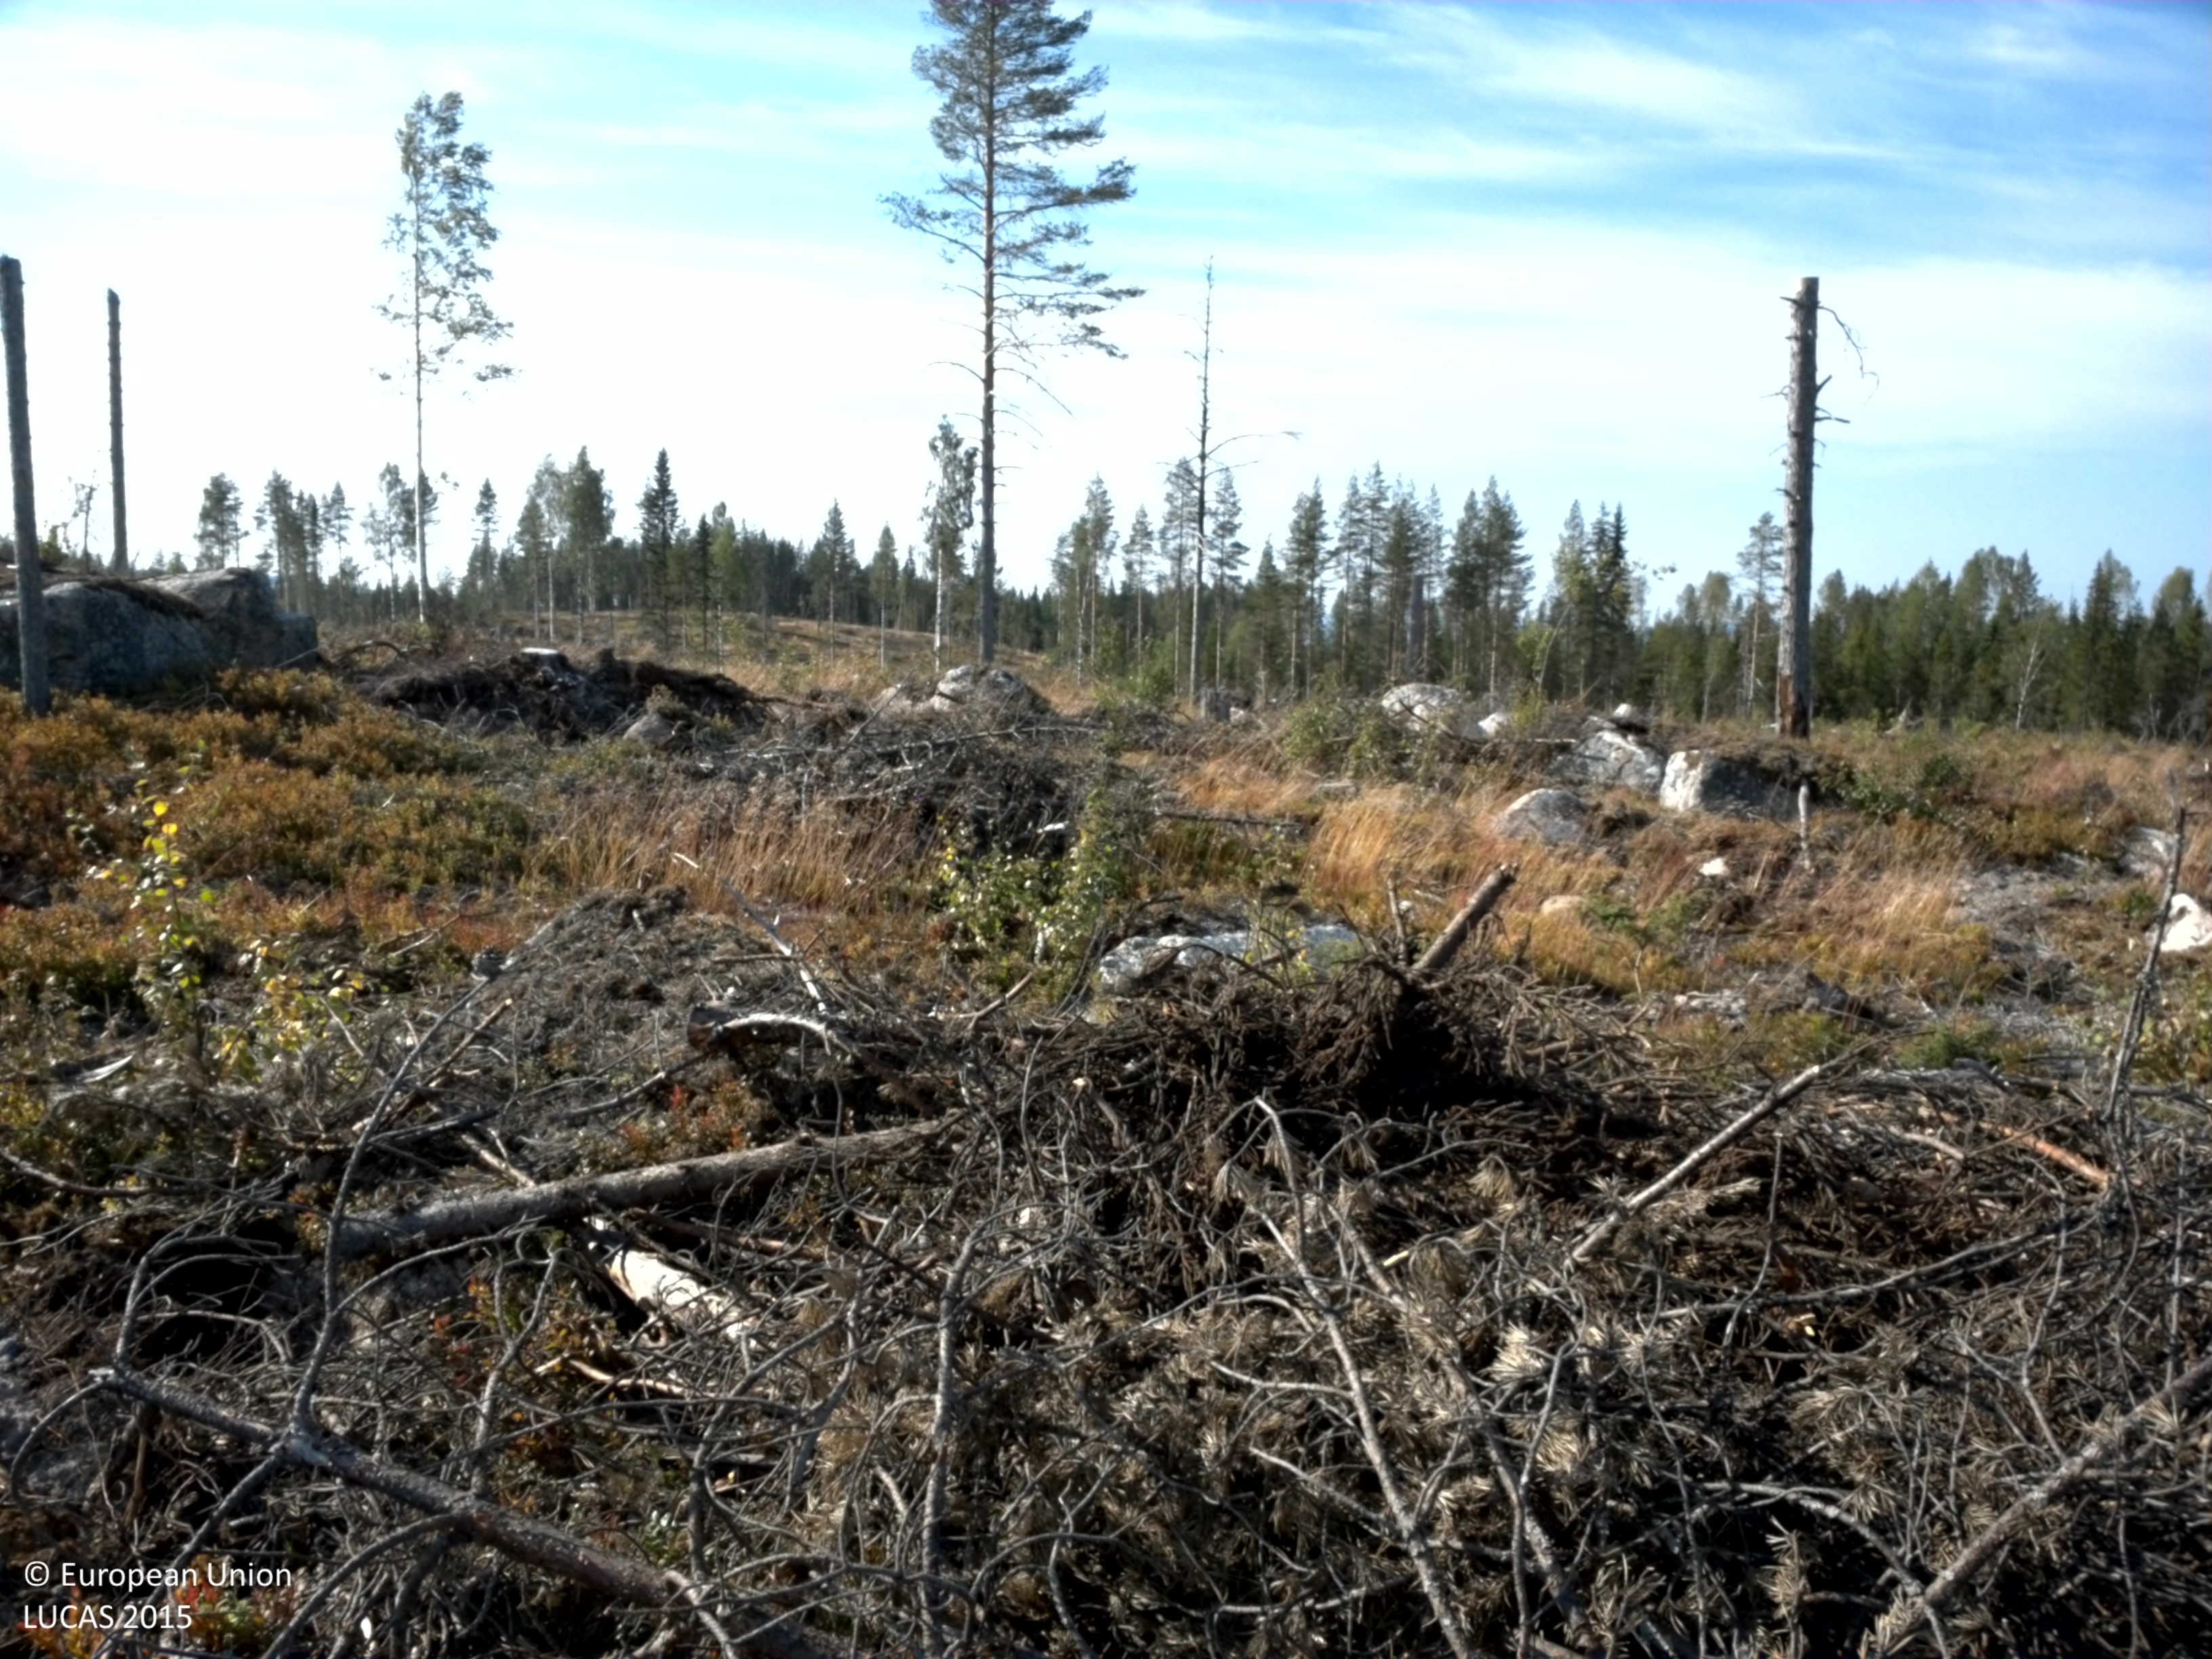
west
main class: Shrubland
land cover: Shrubland without tree cover
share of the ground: > 75 %
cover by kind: shrubs 80 %, consolidated bare surface 5 %, unconsolidated bare surface 5 %
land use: Forestry
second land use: Amenities, museums, leisure
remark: Clear cut
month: August
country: SE
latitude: 64.4983
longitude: 18.8165
